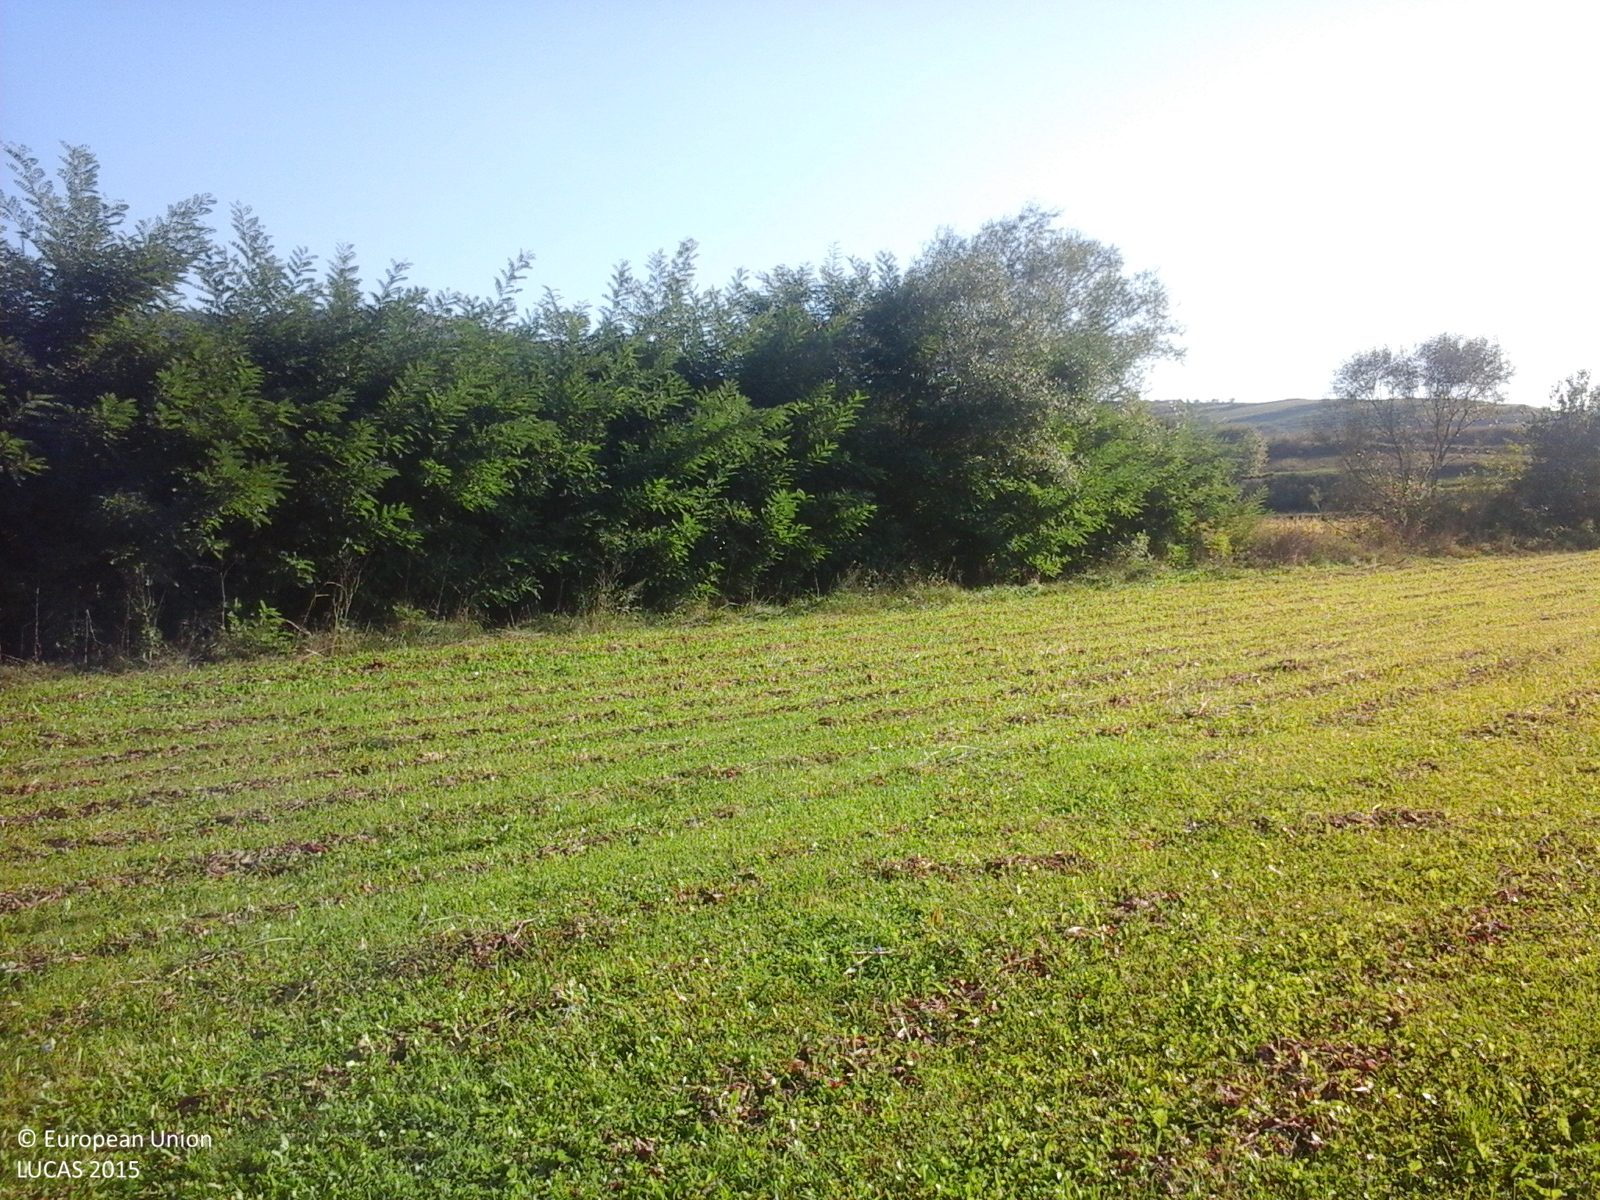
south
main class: Grassland
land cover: Grassland without tree/shrub cover
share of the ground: > 75 %
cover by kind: herbaceous plants 100 %
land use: Agriculture (excluding fallow land and kitchen gardens)
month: October
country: RO
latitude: 46.5474
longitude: 23.5141
